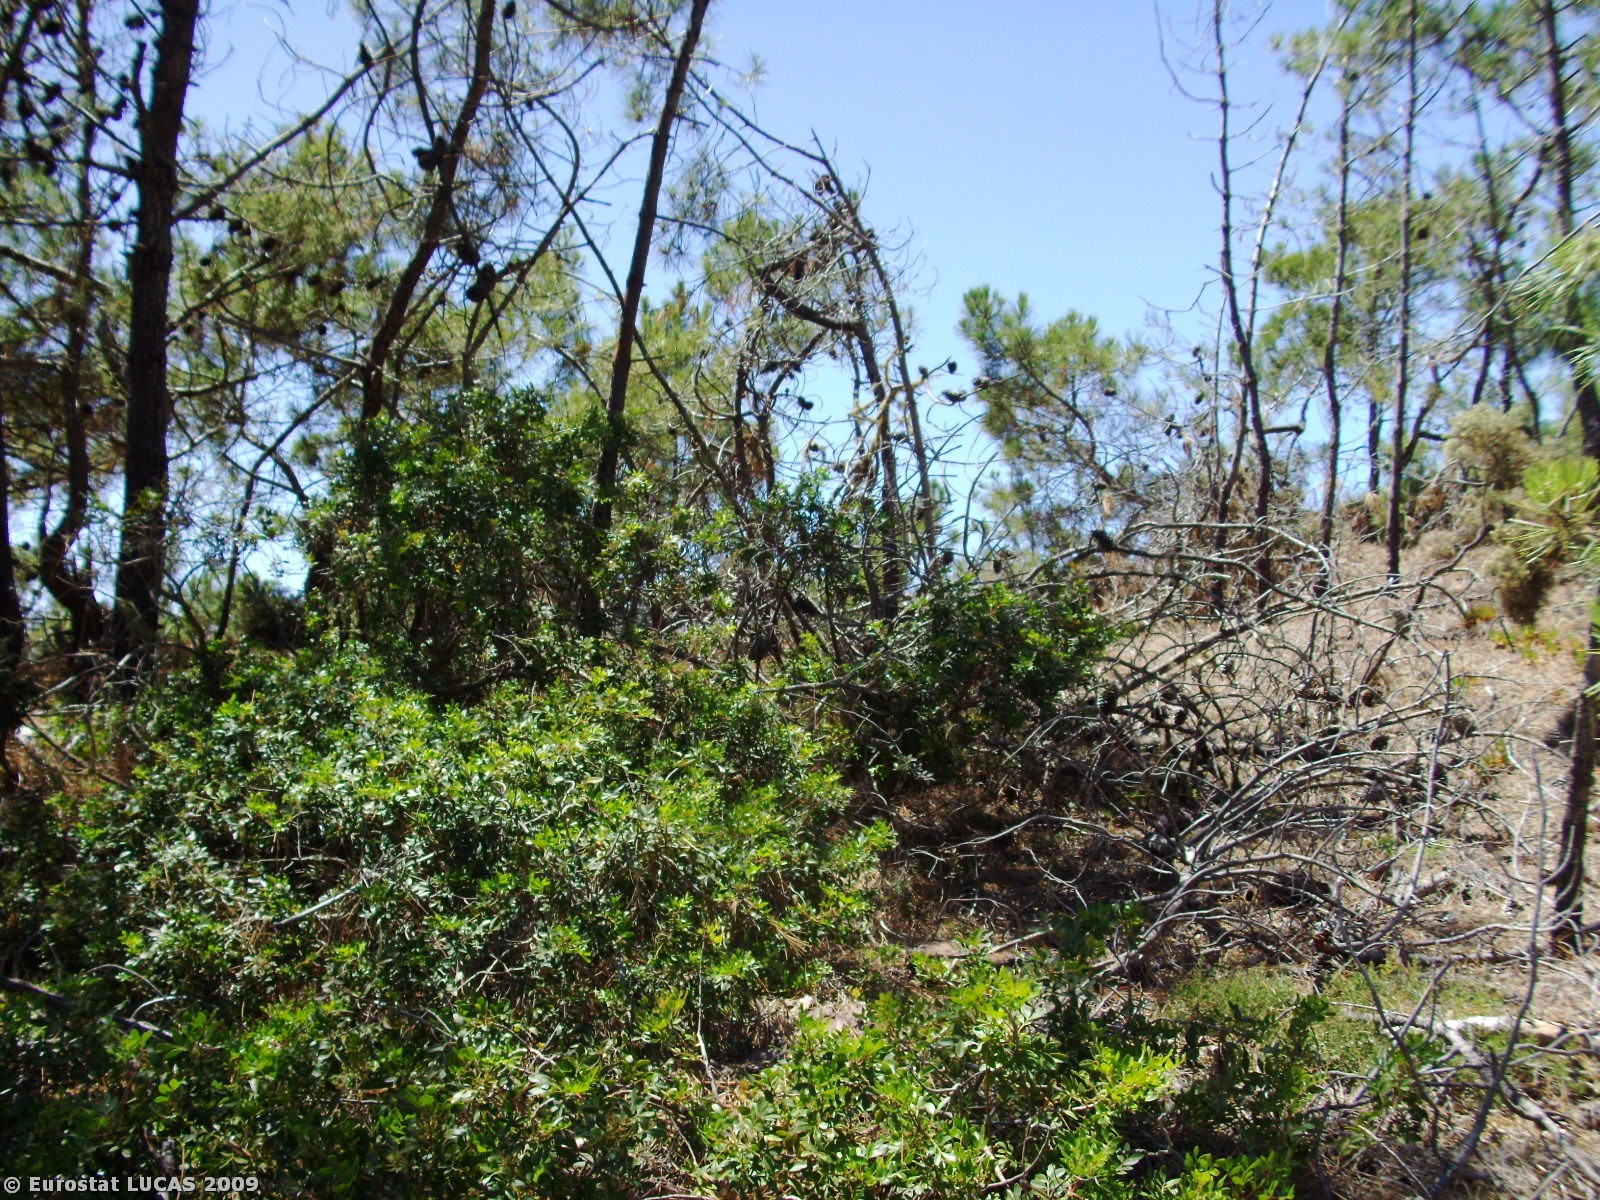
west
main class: Woodland
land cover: Coniferous woodland
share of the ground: > 75 %
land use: Unused
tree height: < 5 m
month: June
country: PT
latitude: 38.2141
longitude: -8.7741
